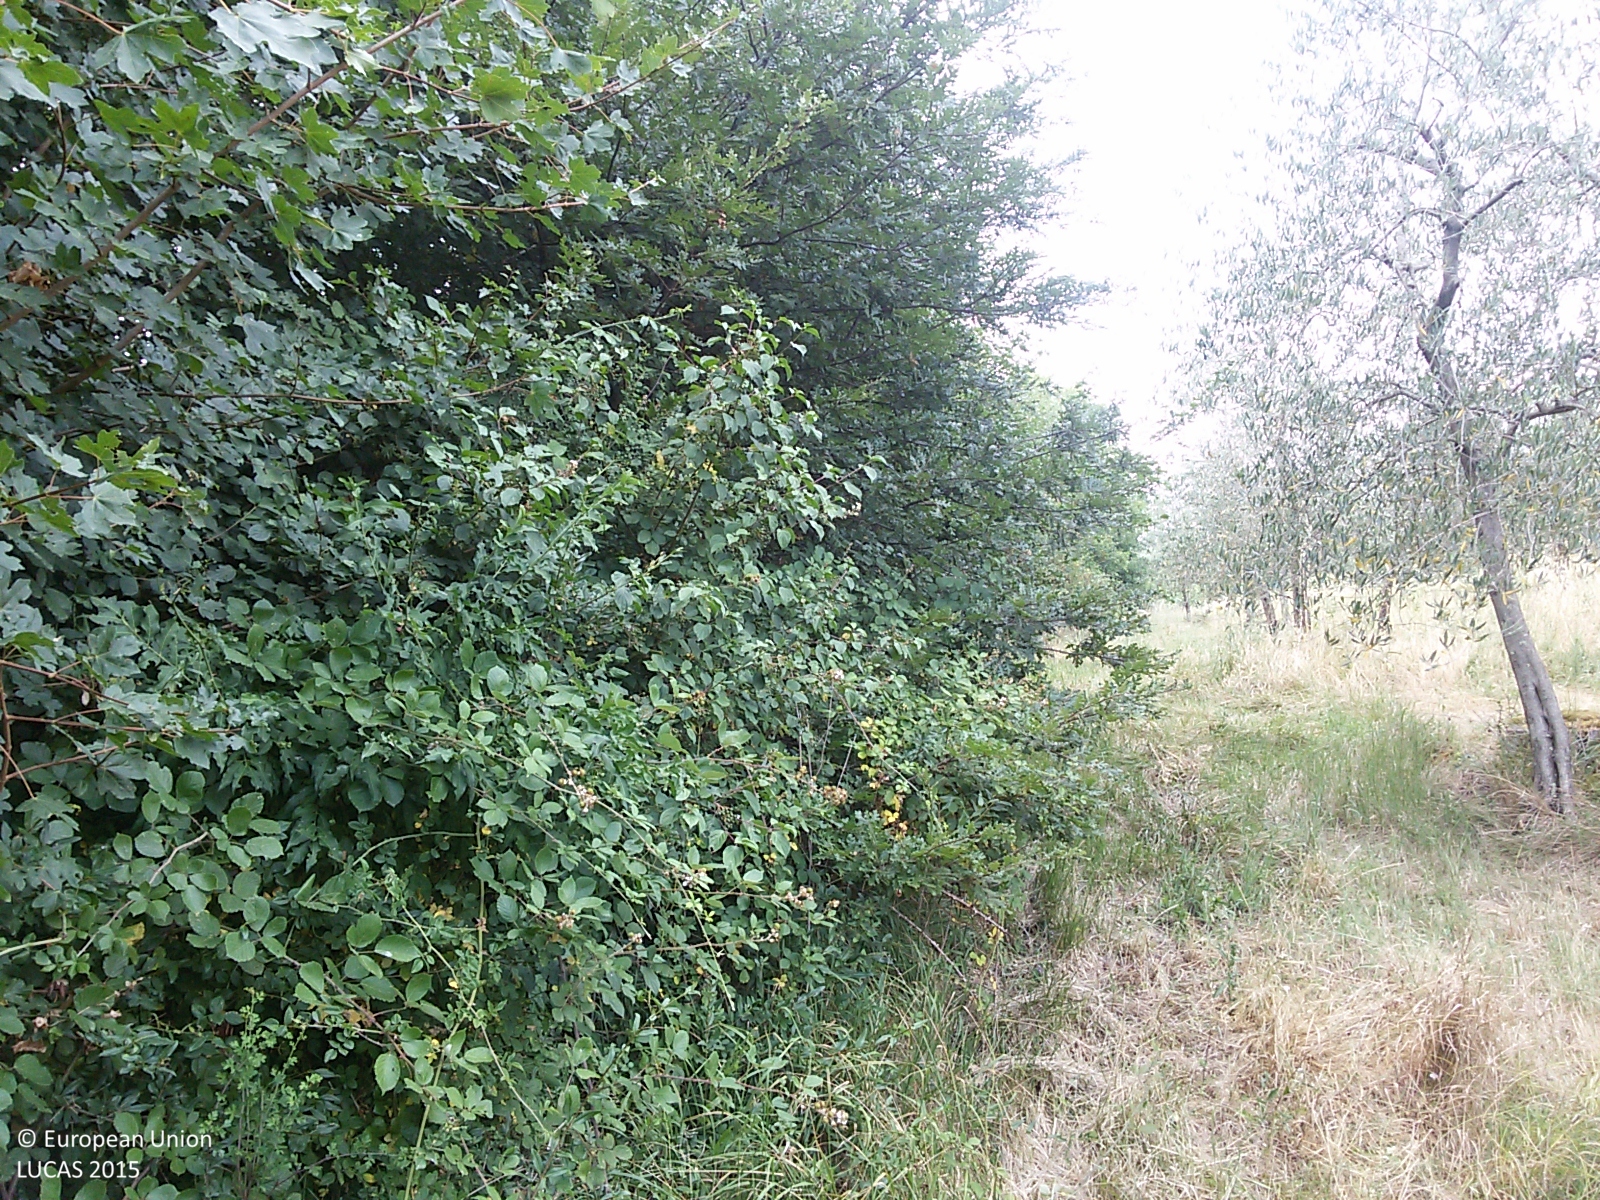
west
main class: Woodland
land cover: Broadleaved woodland
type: thermophilous deciduous forest
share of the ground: > 75 %
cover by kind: broadleaved forest trees 50 %, shrubs 30 %, herbaceous plants 10 %, consolidated bare surface 10 %
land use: Forestry
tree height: < 5 m
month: July
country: IT
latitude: 42.7878
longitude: 11.4744
